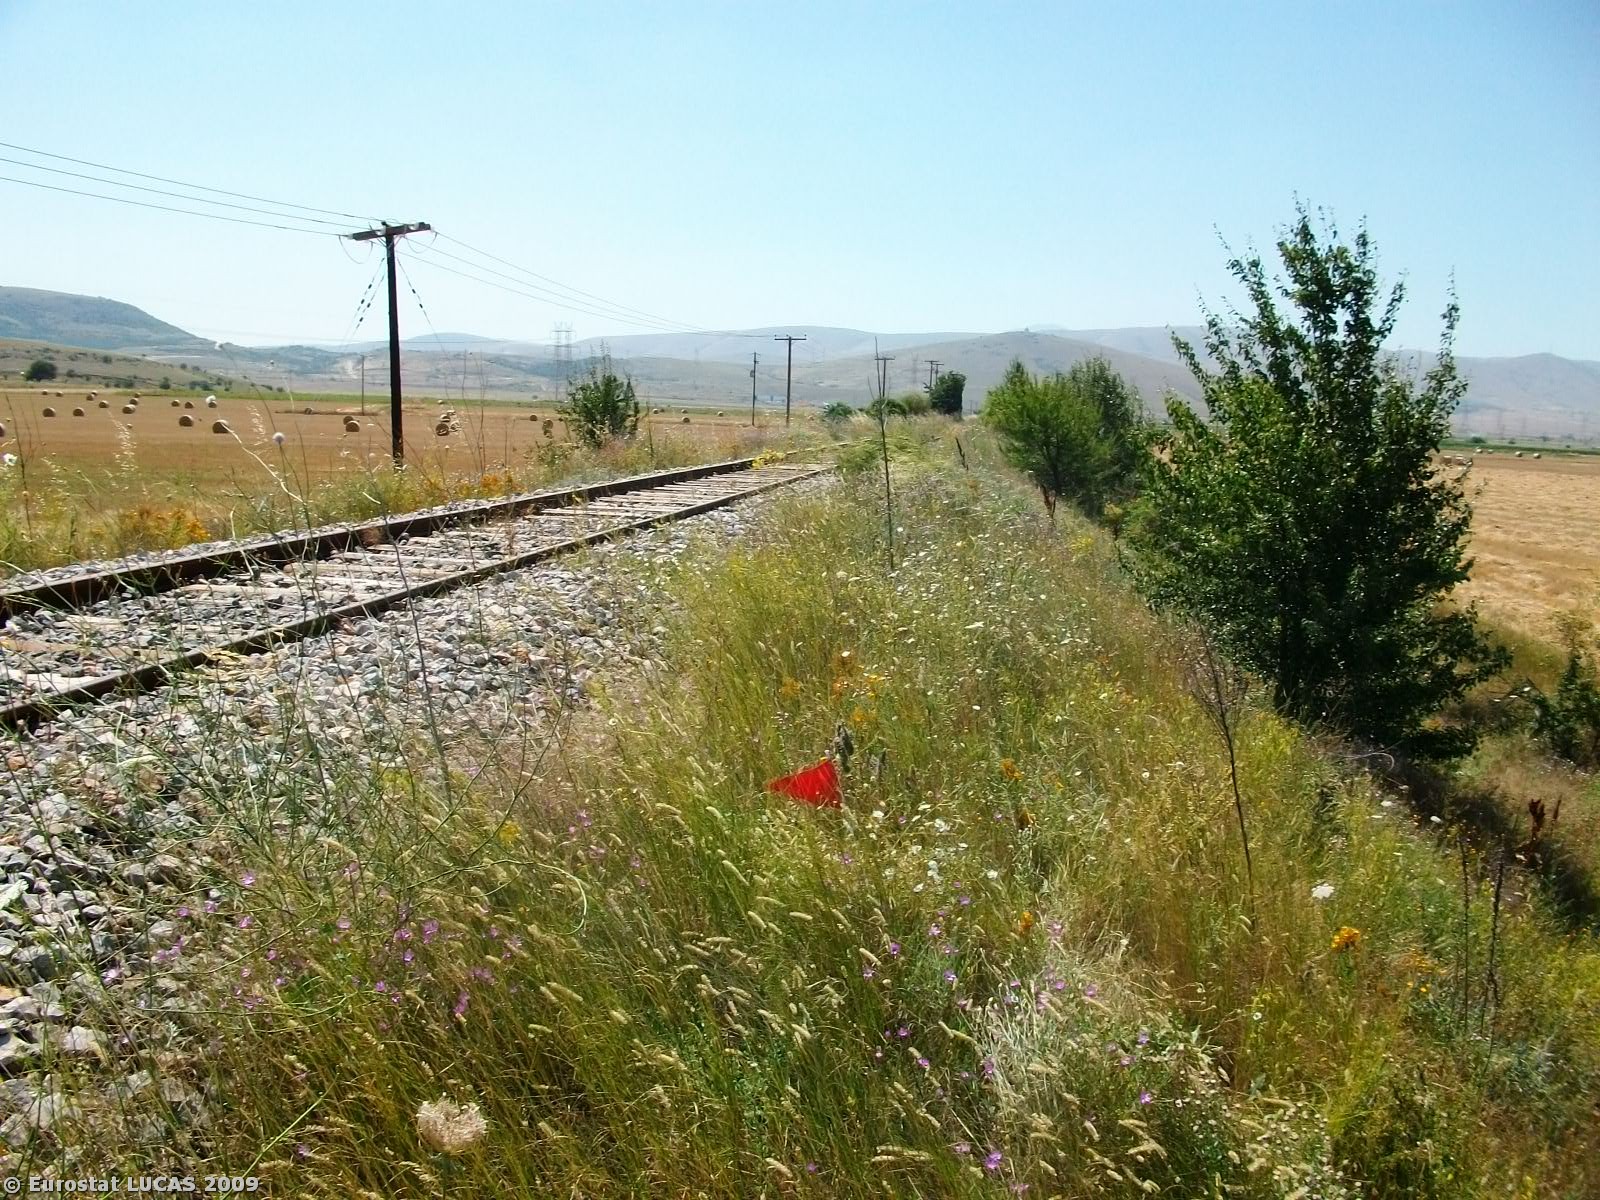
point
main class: Grassland
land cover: Grassland without tree/shrub cover
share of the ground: > 75 %
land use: Unused
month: July
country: GR
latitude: 40.3709
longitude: 21.8291
